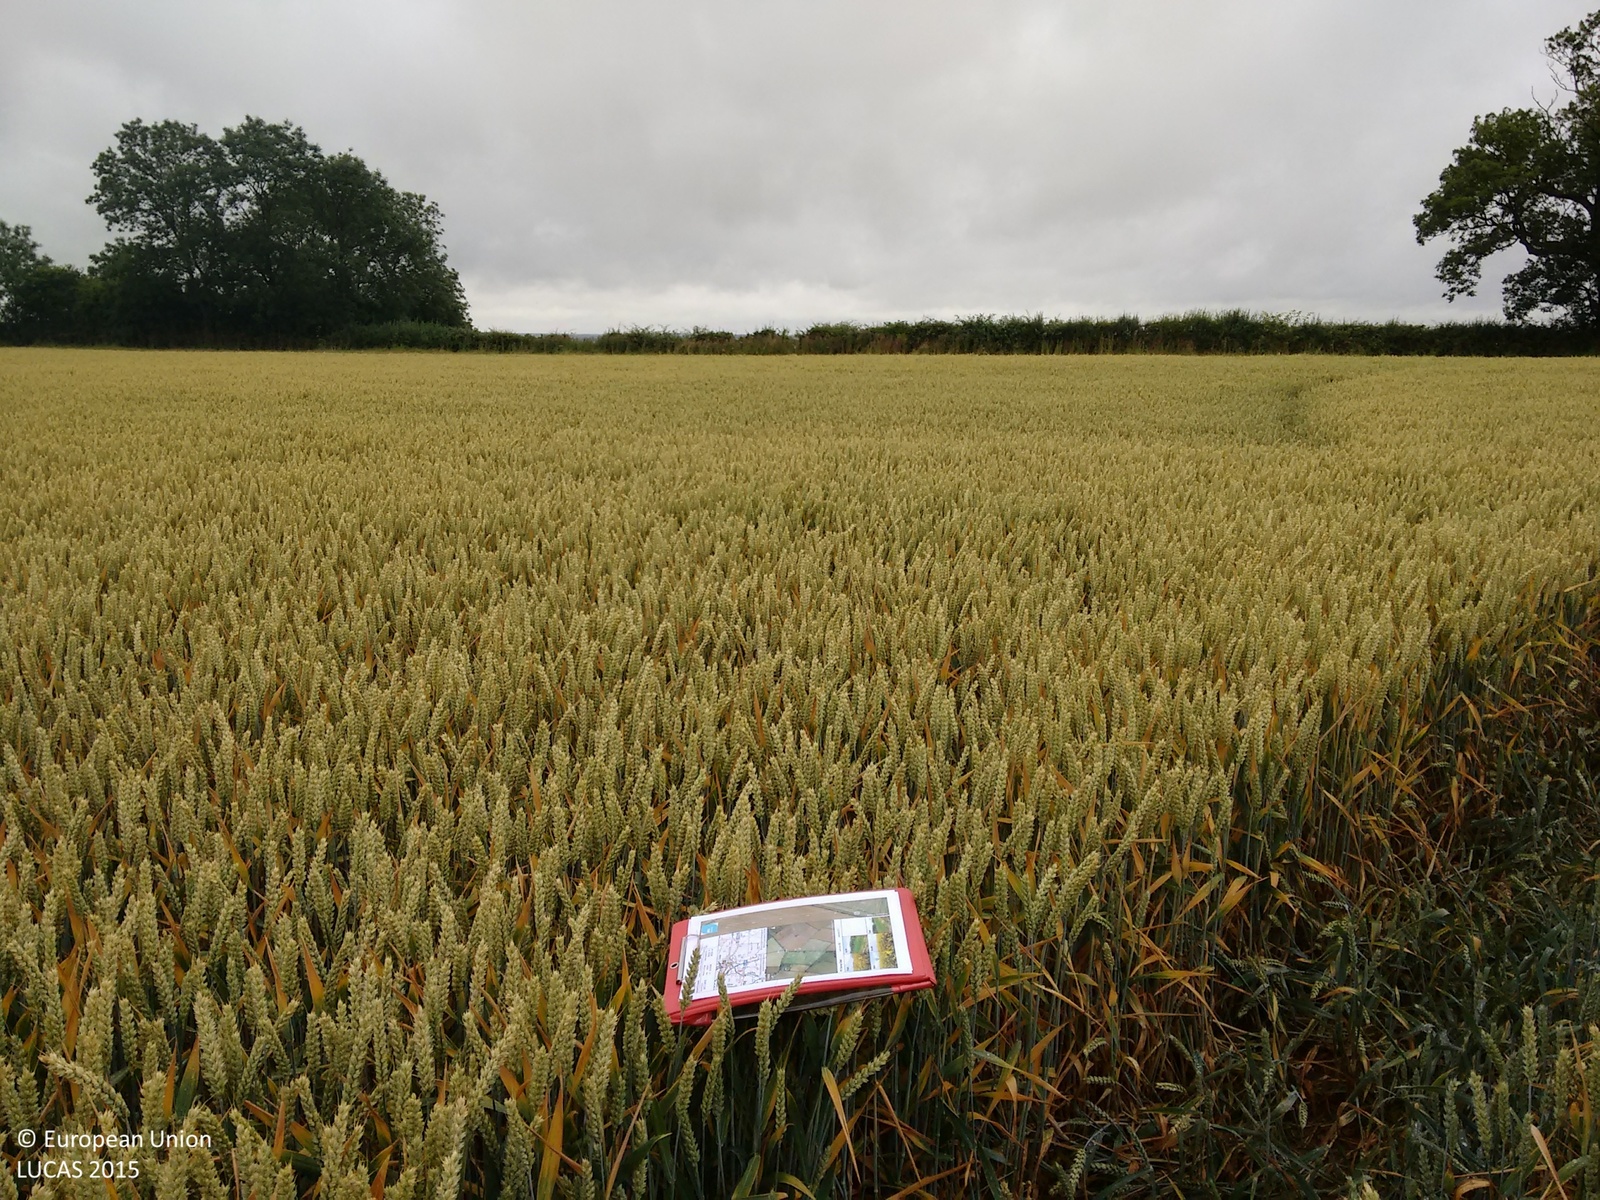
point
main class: Cropland
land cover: Common wheat
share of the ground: > 75 %
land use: Agriculture (excluding fallow land and kitchen gardens)
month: July
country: GB
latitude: 52.5002
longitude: -0.3926
